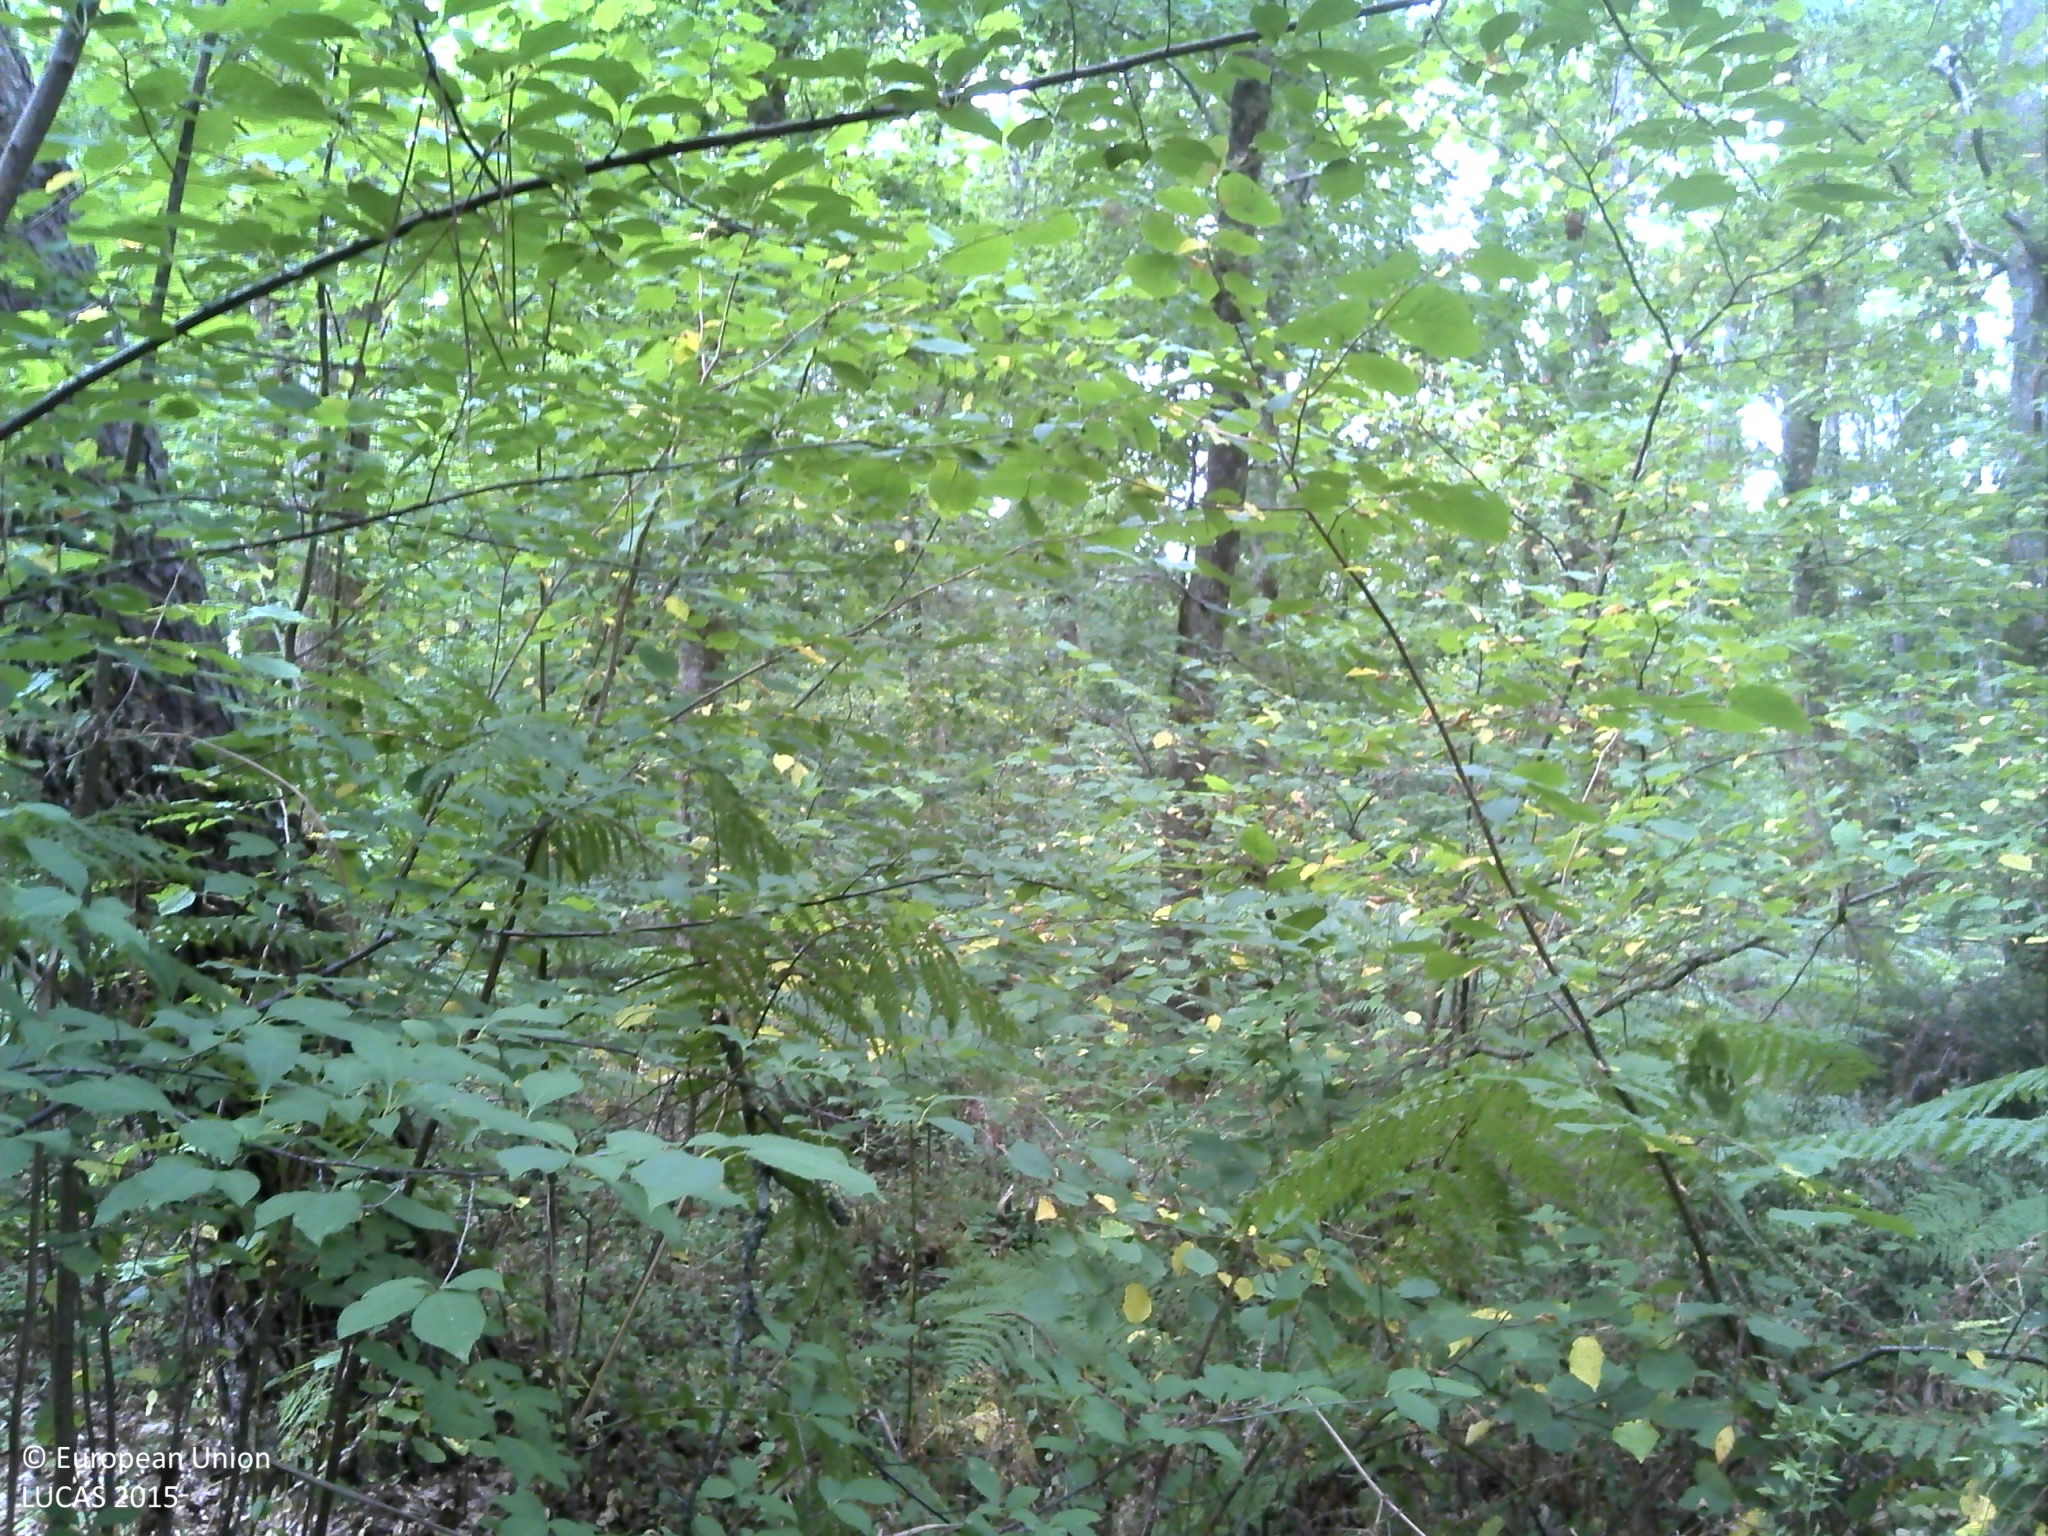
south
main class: Woodland
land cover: Broadleaved woodland
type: floodplain forest
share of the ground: > 75 %
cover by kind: broadleaved forest trees 70 %, shrubs 20 %, herbaceous plants 5 %, lichens and mosses 5 %
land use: Forestry
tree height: > 5 m
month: July
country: FR
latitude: 44.6630
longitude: -0.5738
